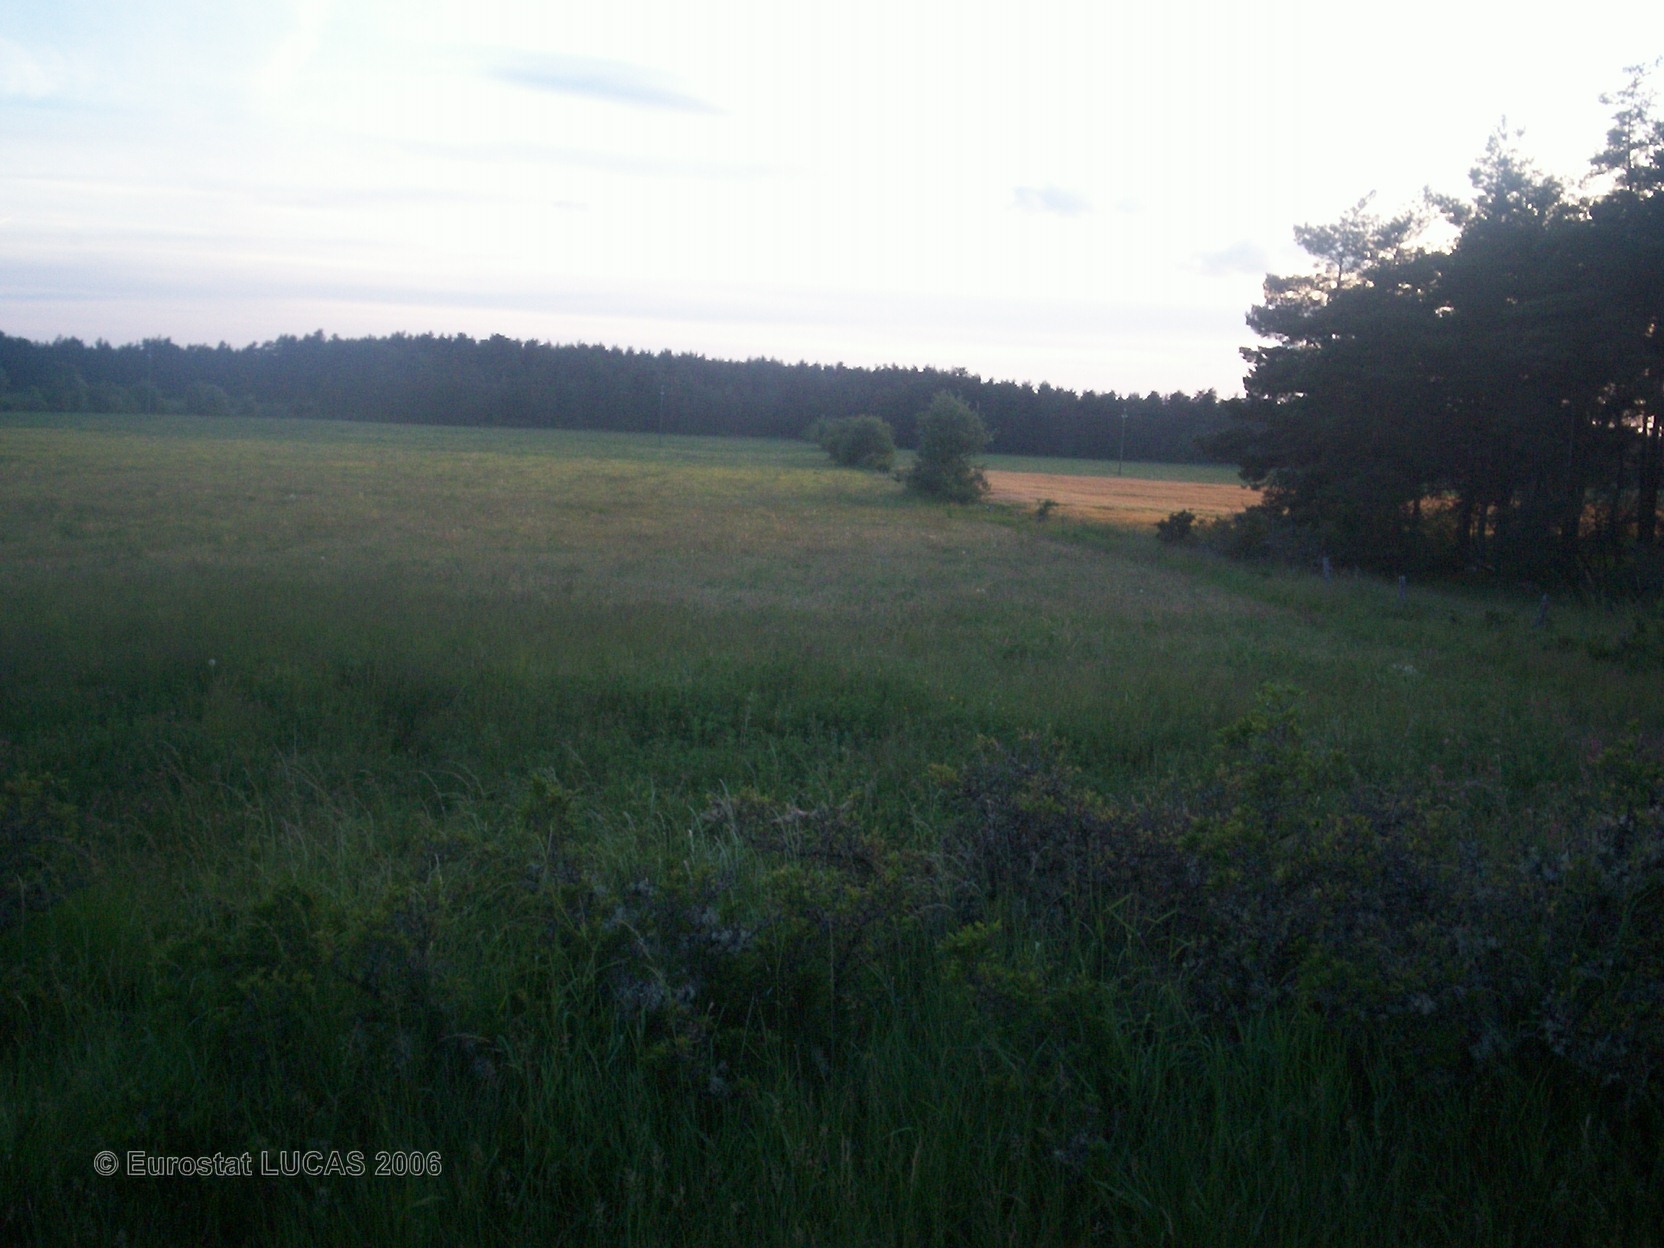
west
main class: Grassland
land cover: Grassland without tree/shrub cover
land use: Agriculture (excluding fallow land and kitchen gardens)
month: June
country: FR
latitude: 44.4484
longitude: 3.4082
